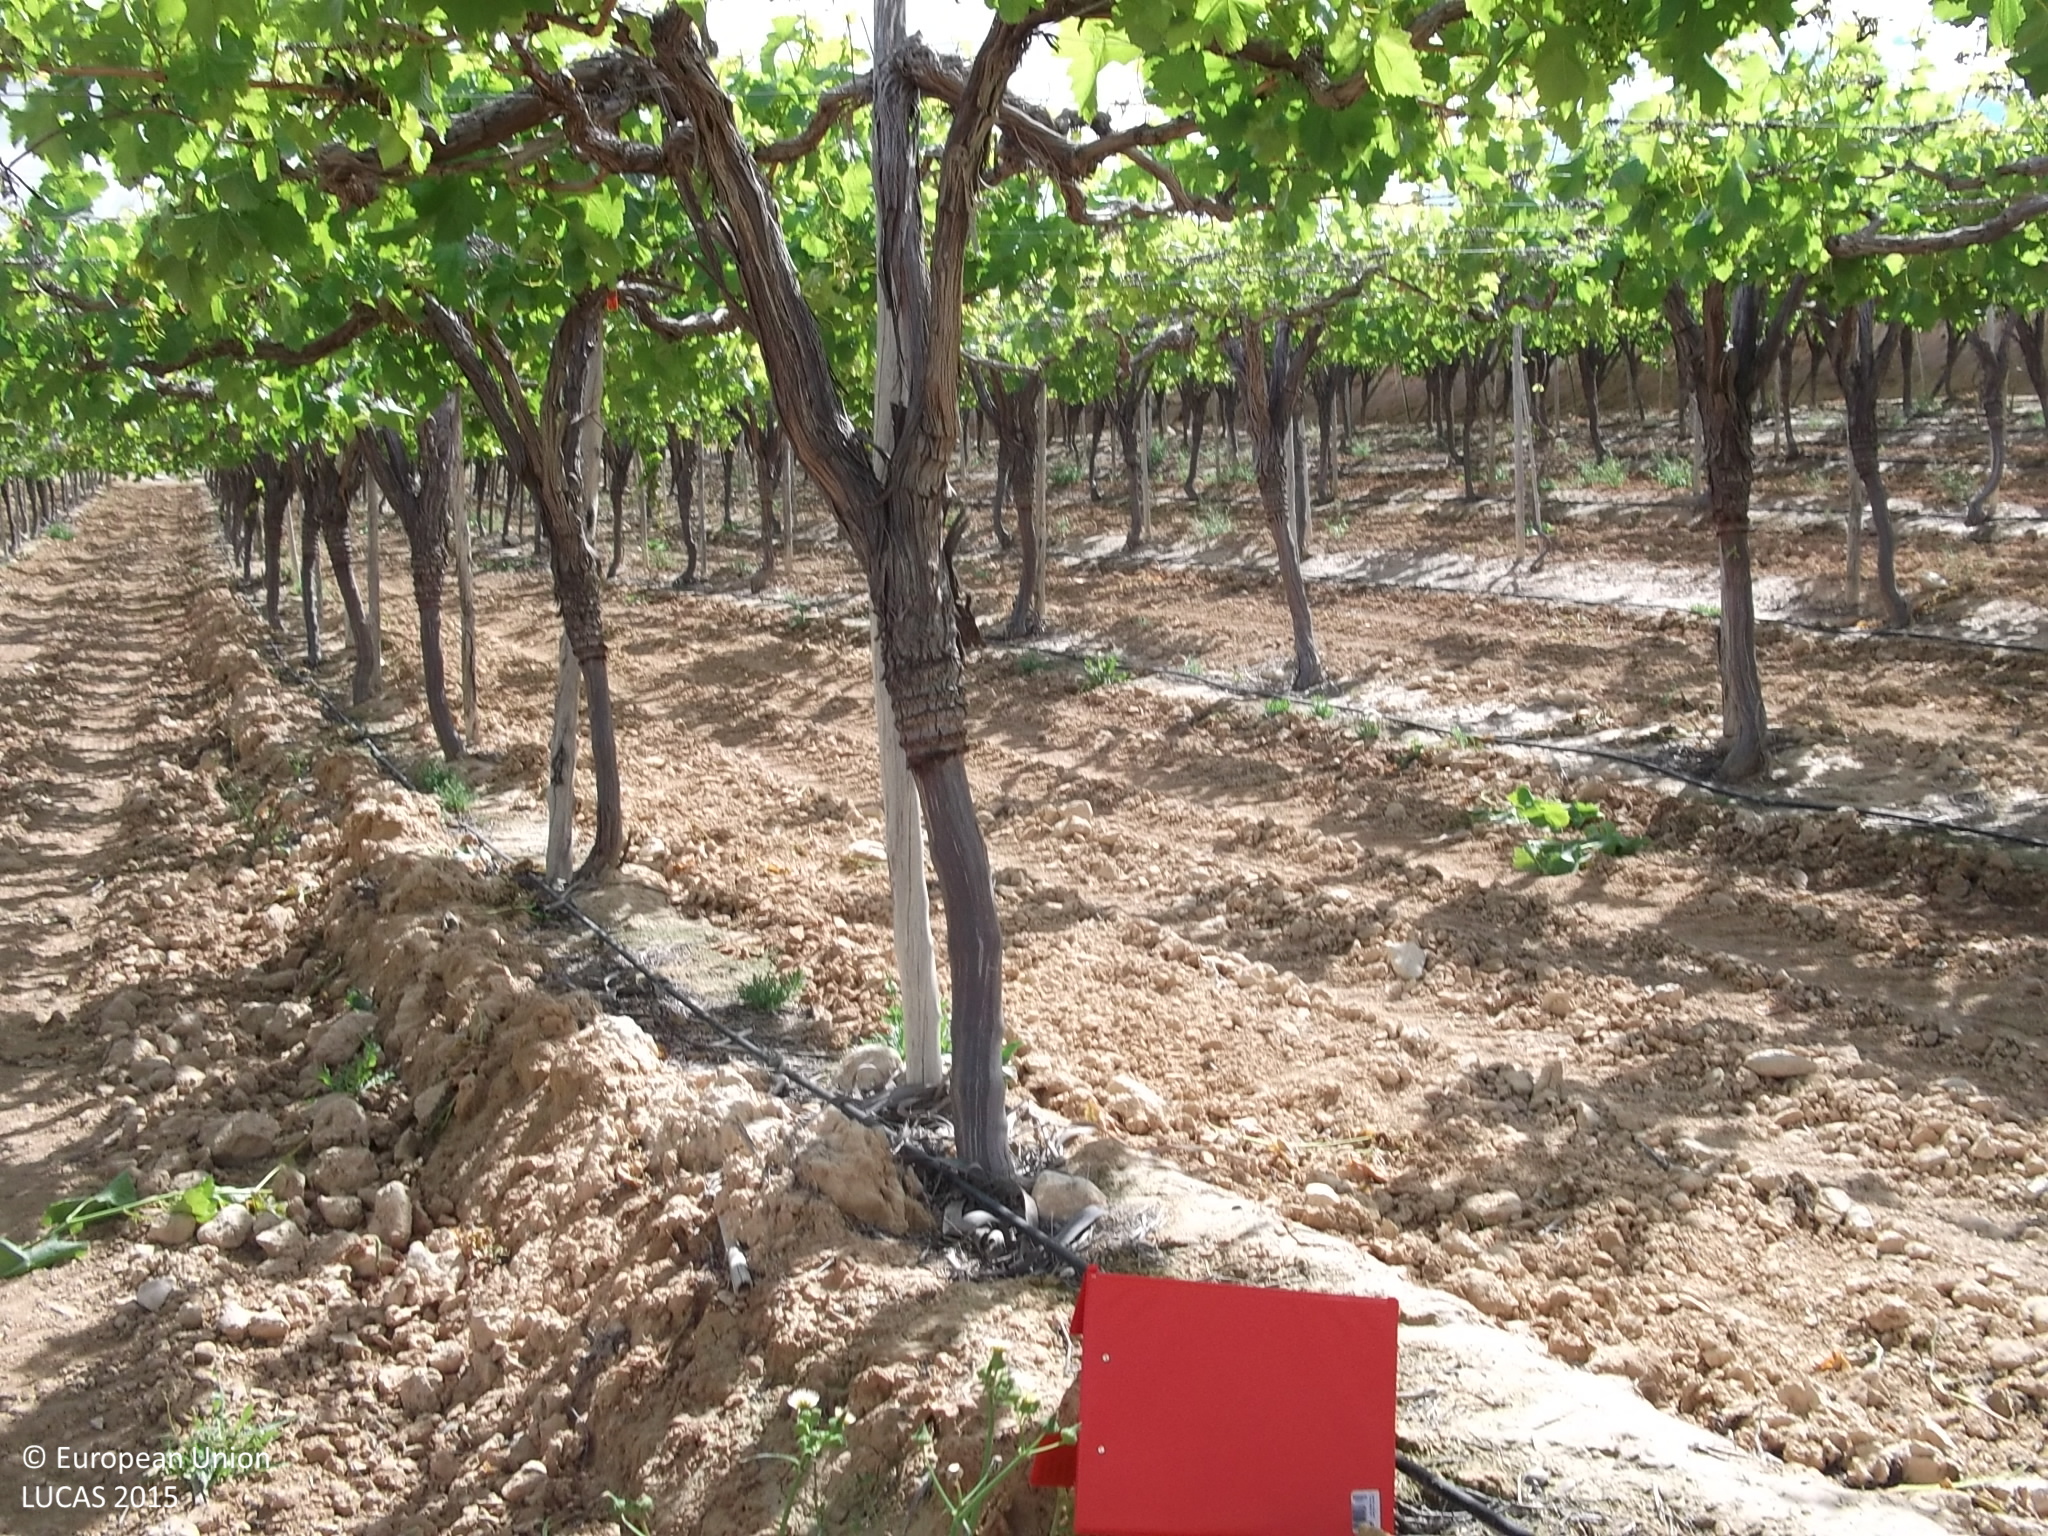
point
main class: Cropland
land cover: Vineyards
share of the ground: > 75 %
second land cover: Other bare soil
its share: > 75 %
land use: Agriculture (excluding fallow land and kitchen gardens)
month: April
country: ES
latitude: 38.2742
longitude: -1.3391
